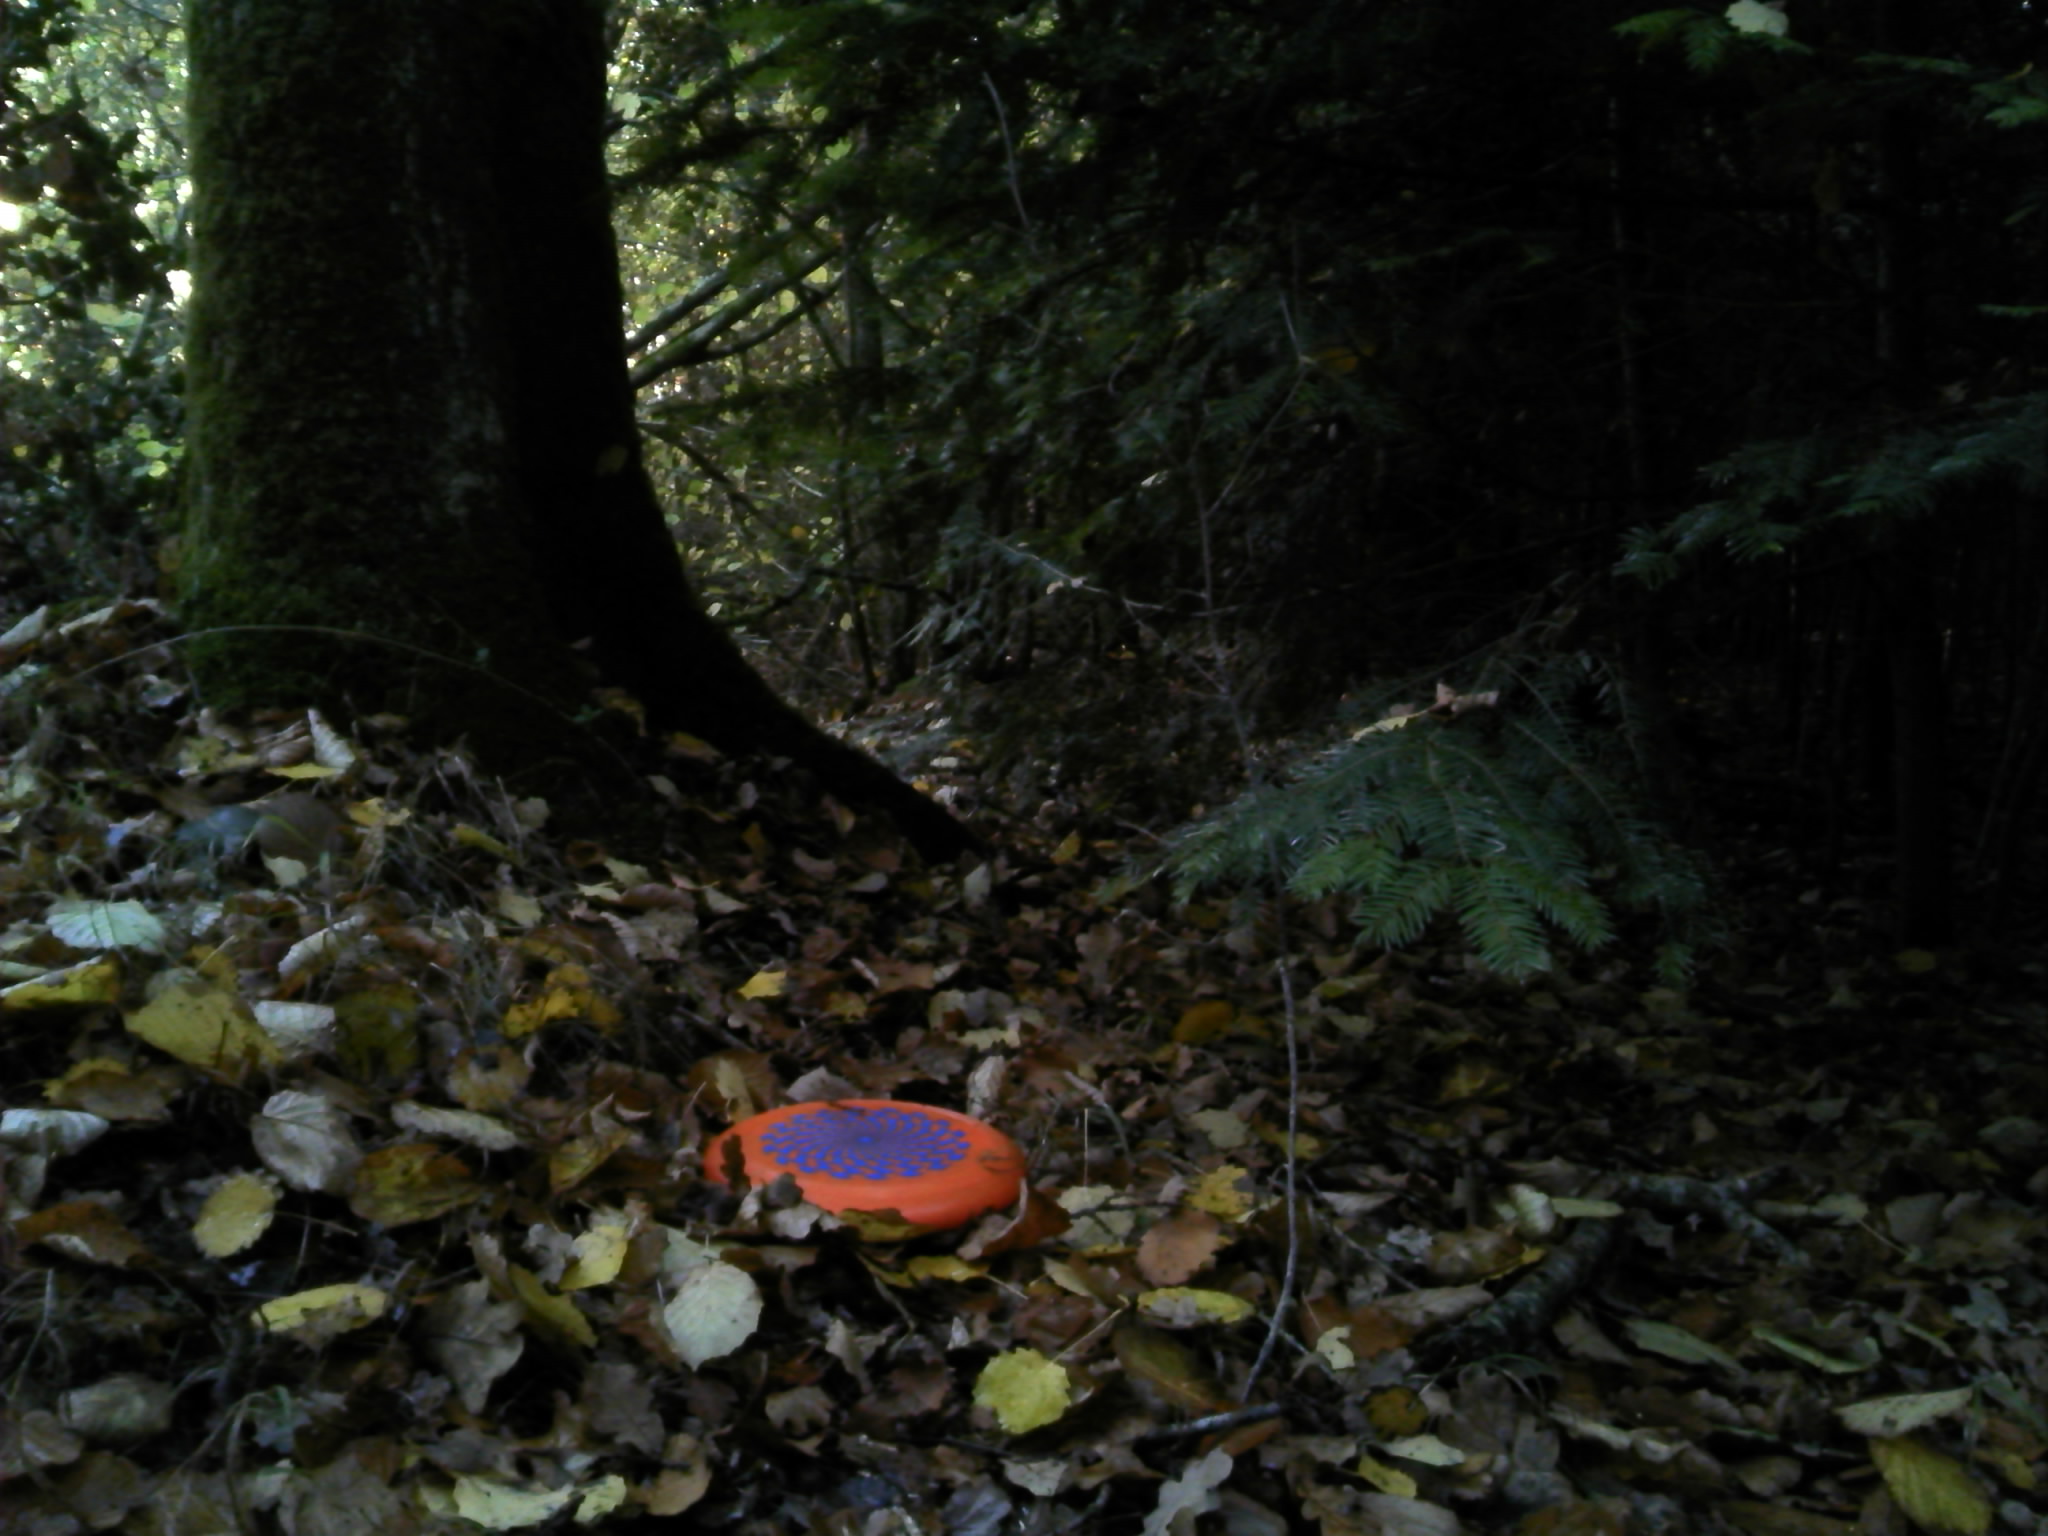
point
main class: Woodland
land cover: Other mixed woodland
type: hemiboreal forest and nemoral coniferous forest and mixed broadleaved-coniferous forest
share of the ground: > 75 %
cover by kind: coniferous forest trees 50 %, broadleaved forest trees 50 %
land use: Forestry
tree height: > 5 m
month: November
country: FR
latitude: 47.7372
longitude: -1.0667
